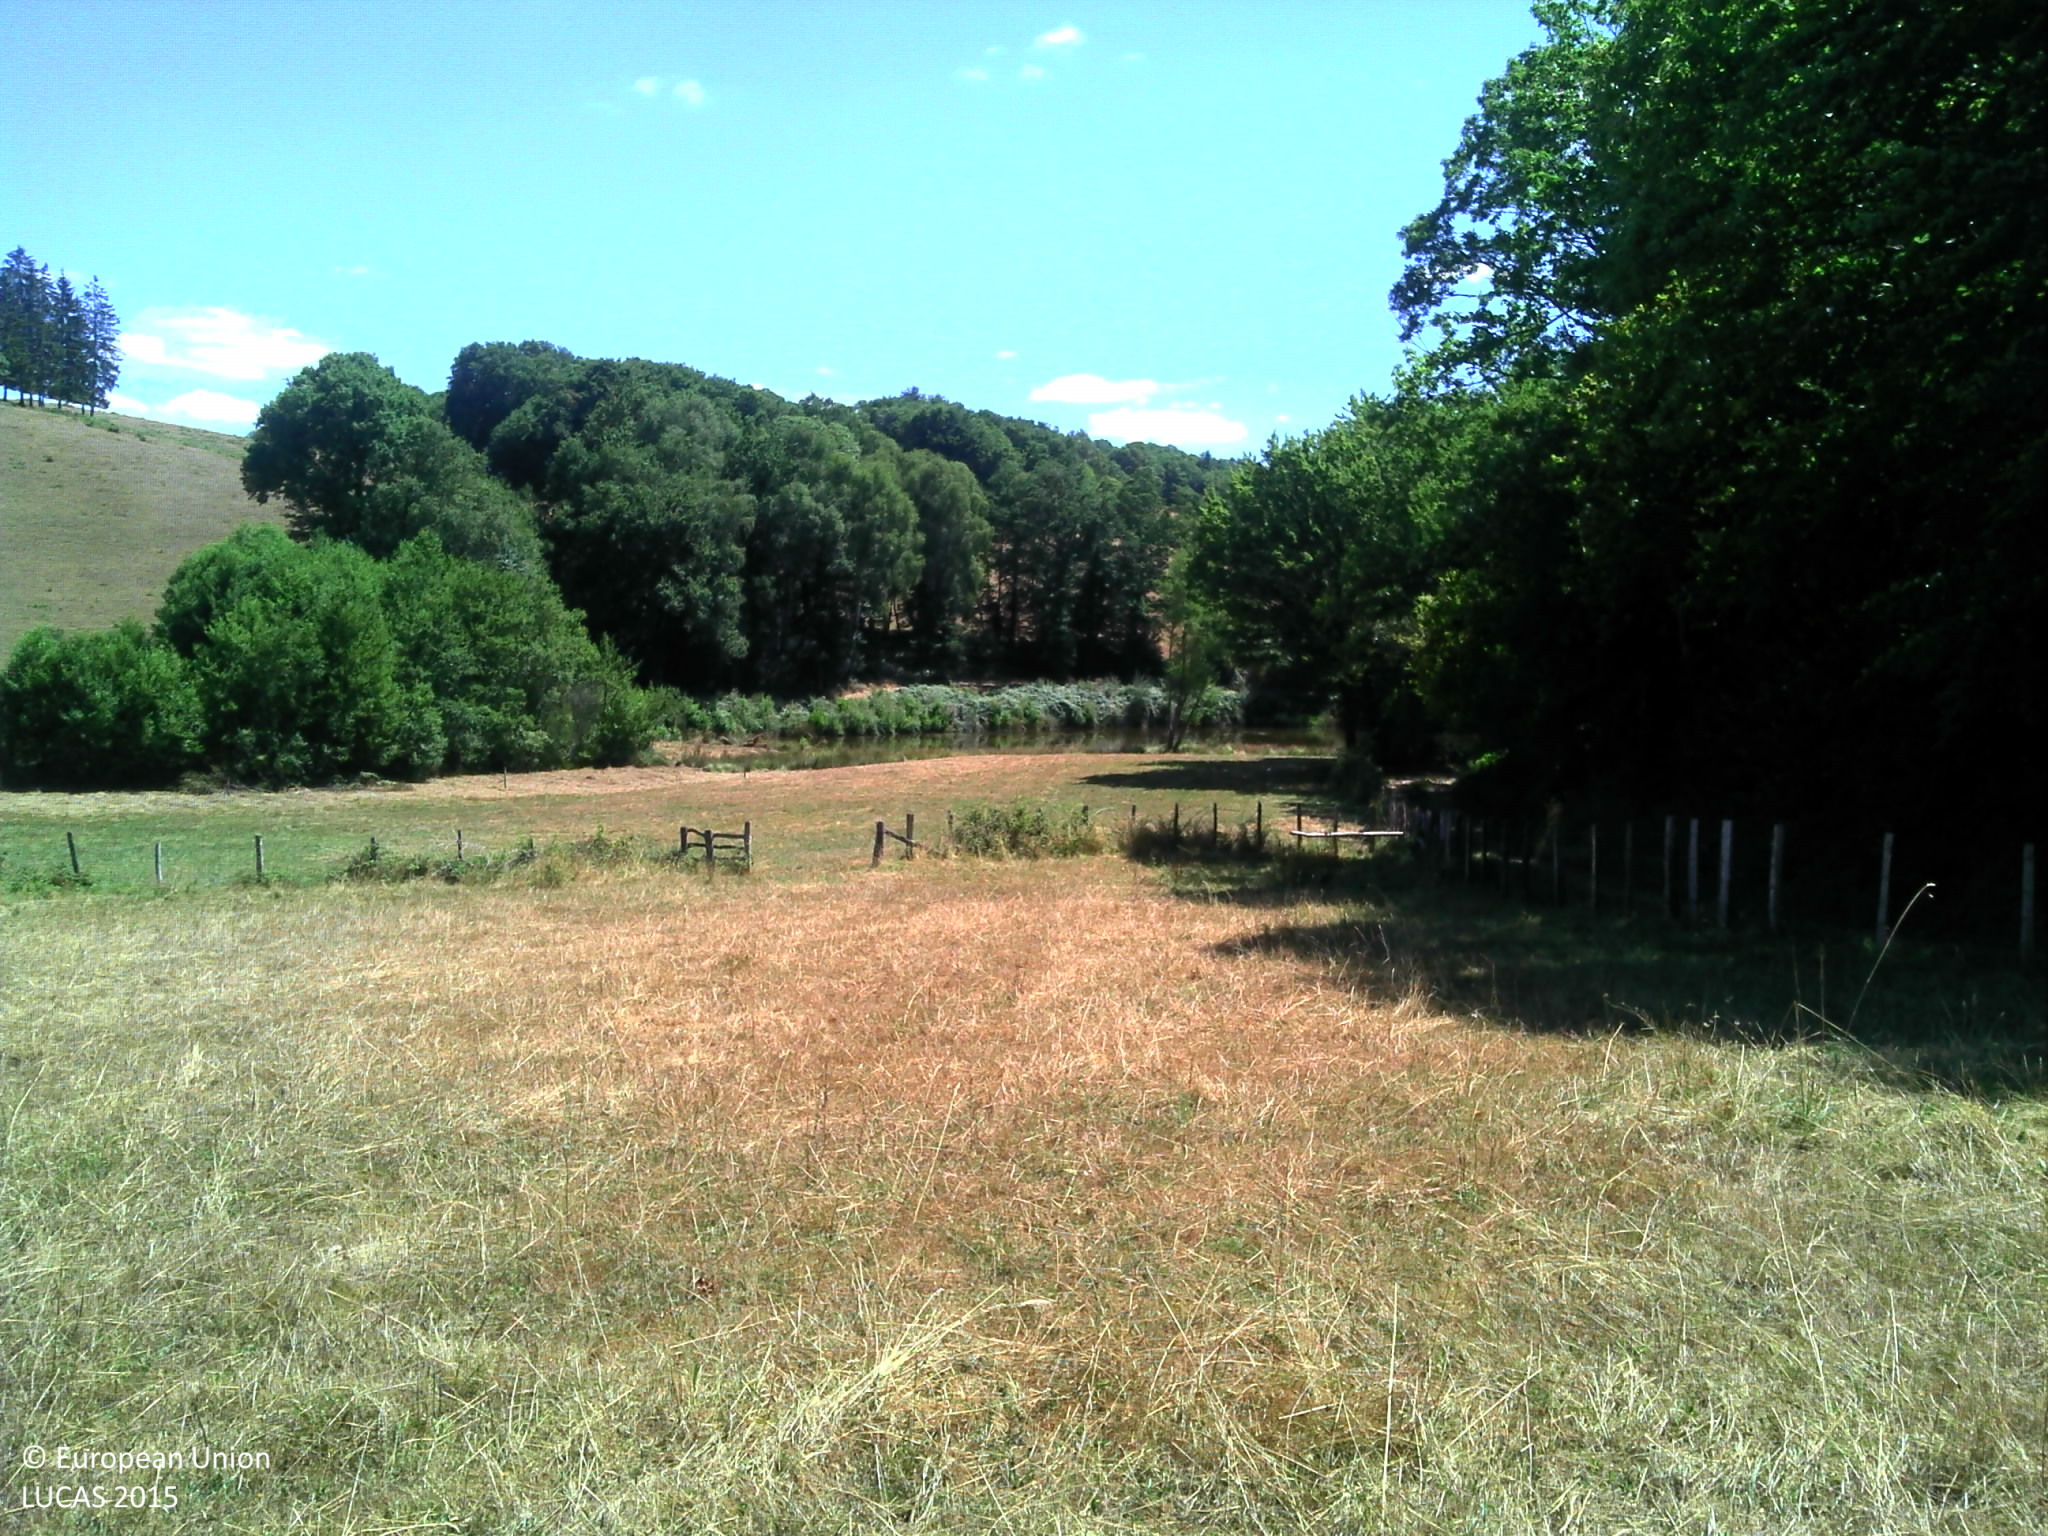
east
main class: Grassland
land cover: Grassland without tree/shrub cover
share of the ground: > 75 %
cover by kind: herbaceous plants 100 %
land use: Agriculture (excluding fallow land and kitchen gardens)
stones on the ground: < 10 %
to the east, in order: Grassland without tree/shrub cover; Fences; Abandoned hedges; Grassland without tree/shrub cover; Fences; Spontaneously vegetated surfaces; Inland fresh water bodies; Spontaneously vegetated surfaces; Broadleaved woodland; Tracks; Fences; Grassland without tree/shrub cover
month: July
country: FR
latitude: 45.5718
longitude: 1.6523
